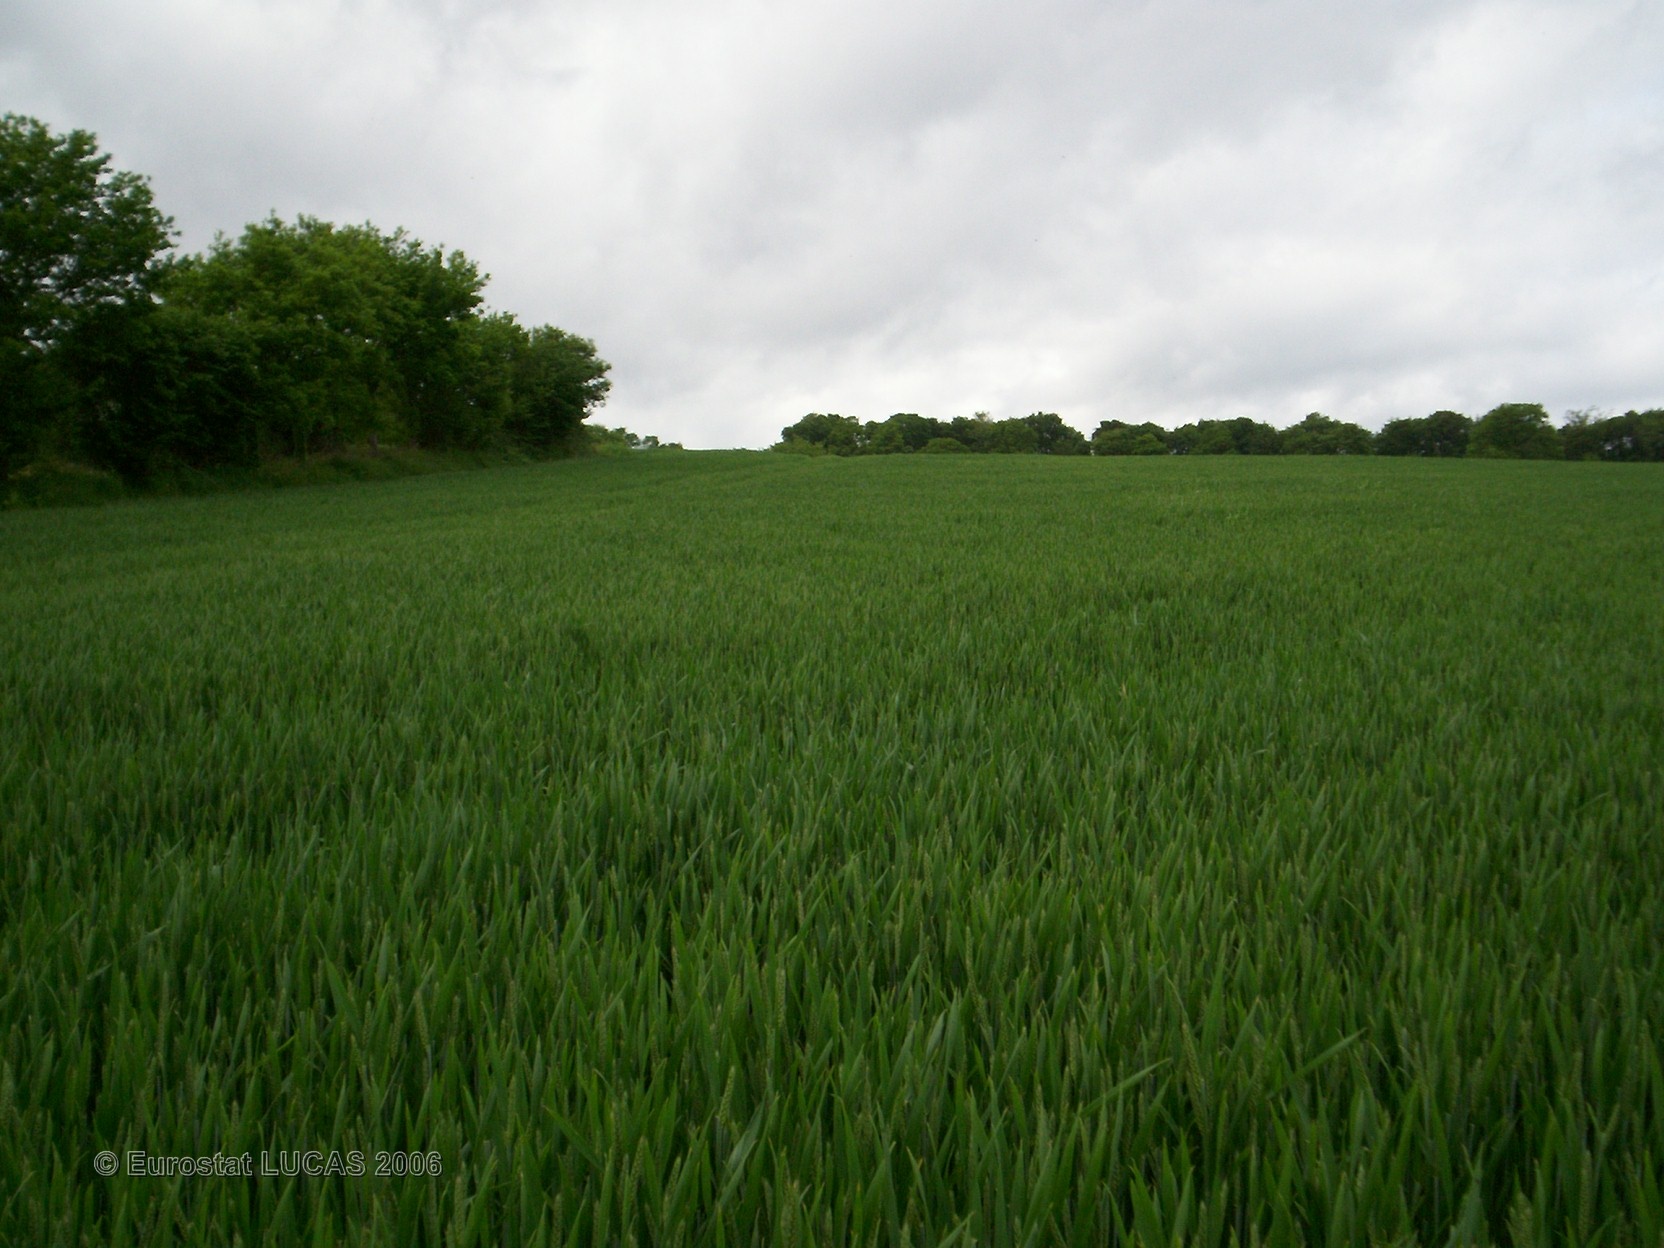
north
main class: Cropland
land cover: Common wheat
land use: Agriculture (excluding fallow land and kitchen gardens)
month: May
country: FR
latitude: 48.2090
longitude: -2.4263
